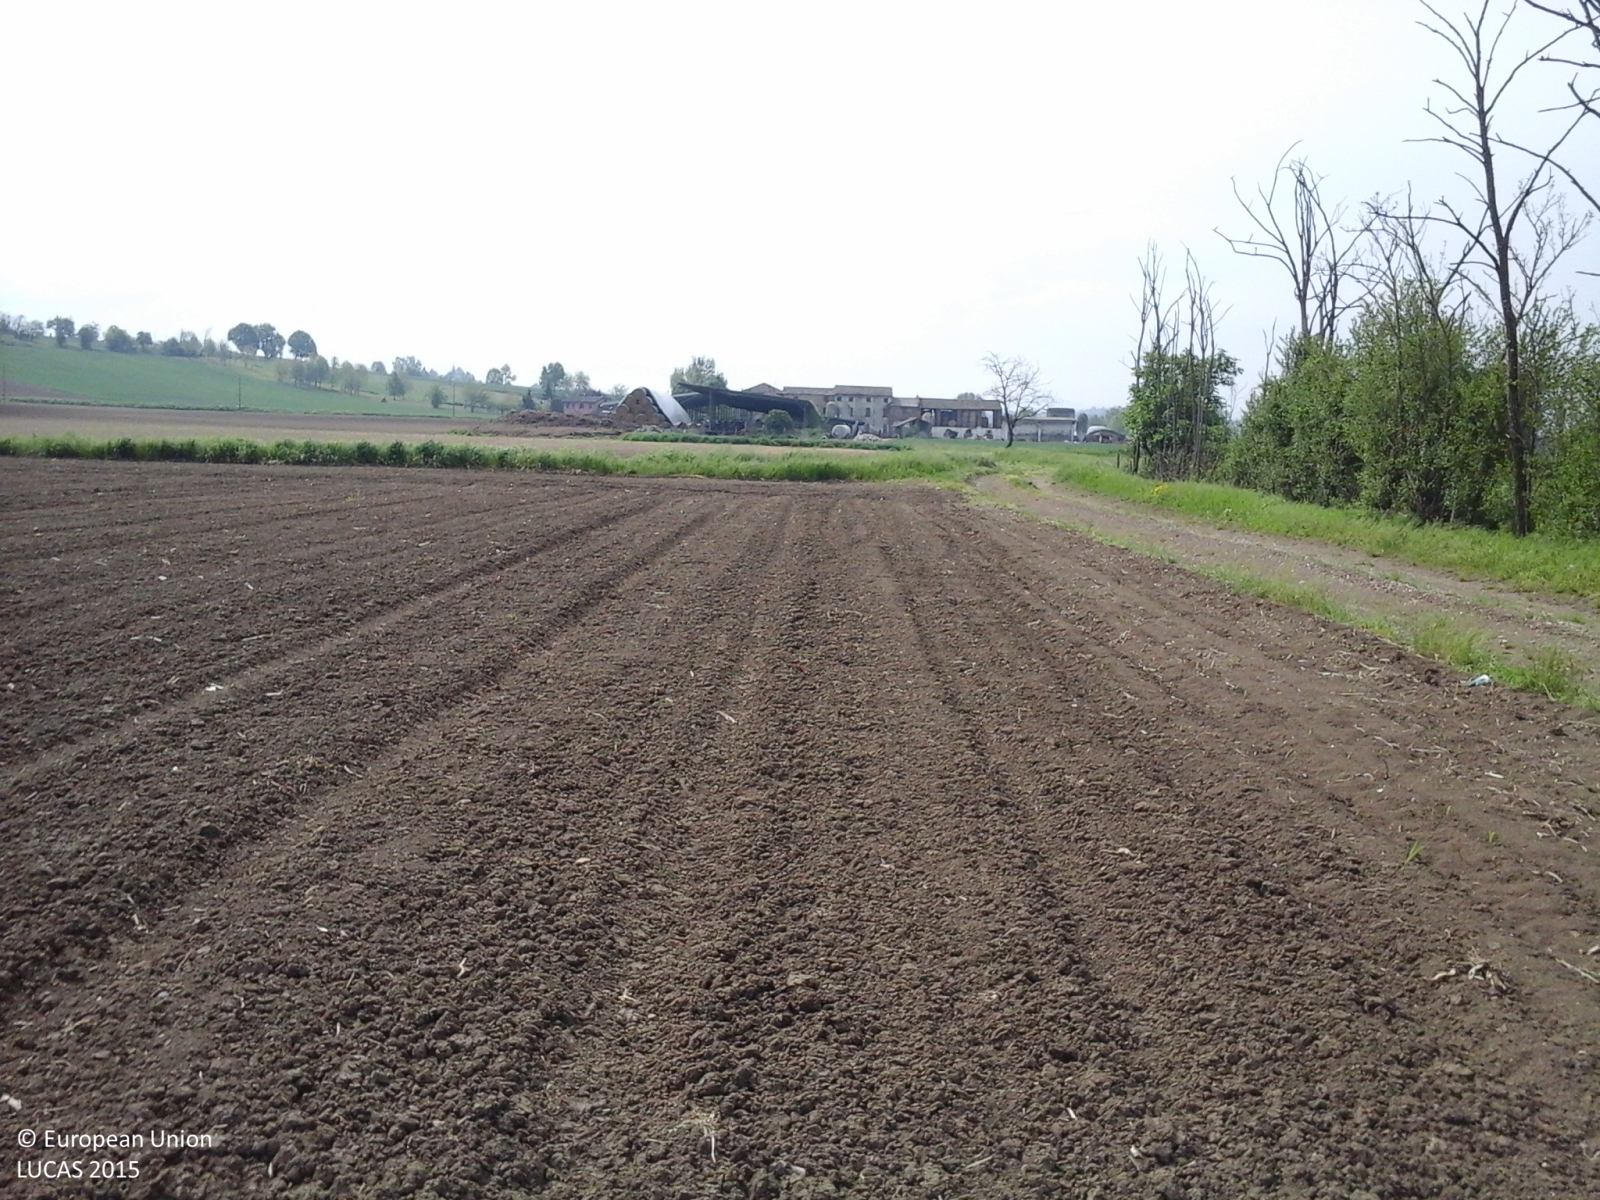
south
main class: Cropland
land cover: Maize
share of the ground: < 10 %
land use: Agriculture (excluding fallow land and kitchen gardens)
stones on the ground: < 10 %
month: April
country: IT
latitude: 45.0519
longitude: 9.3790
